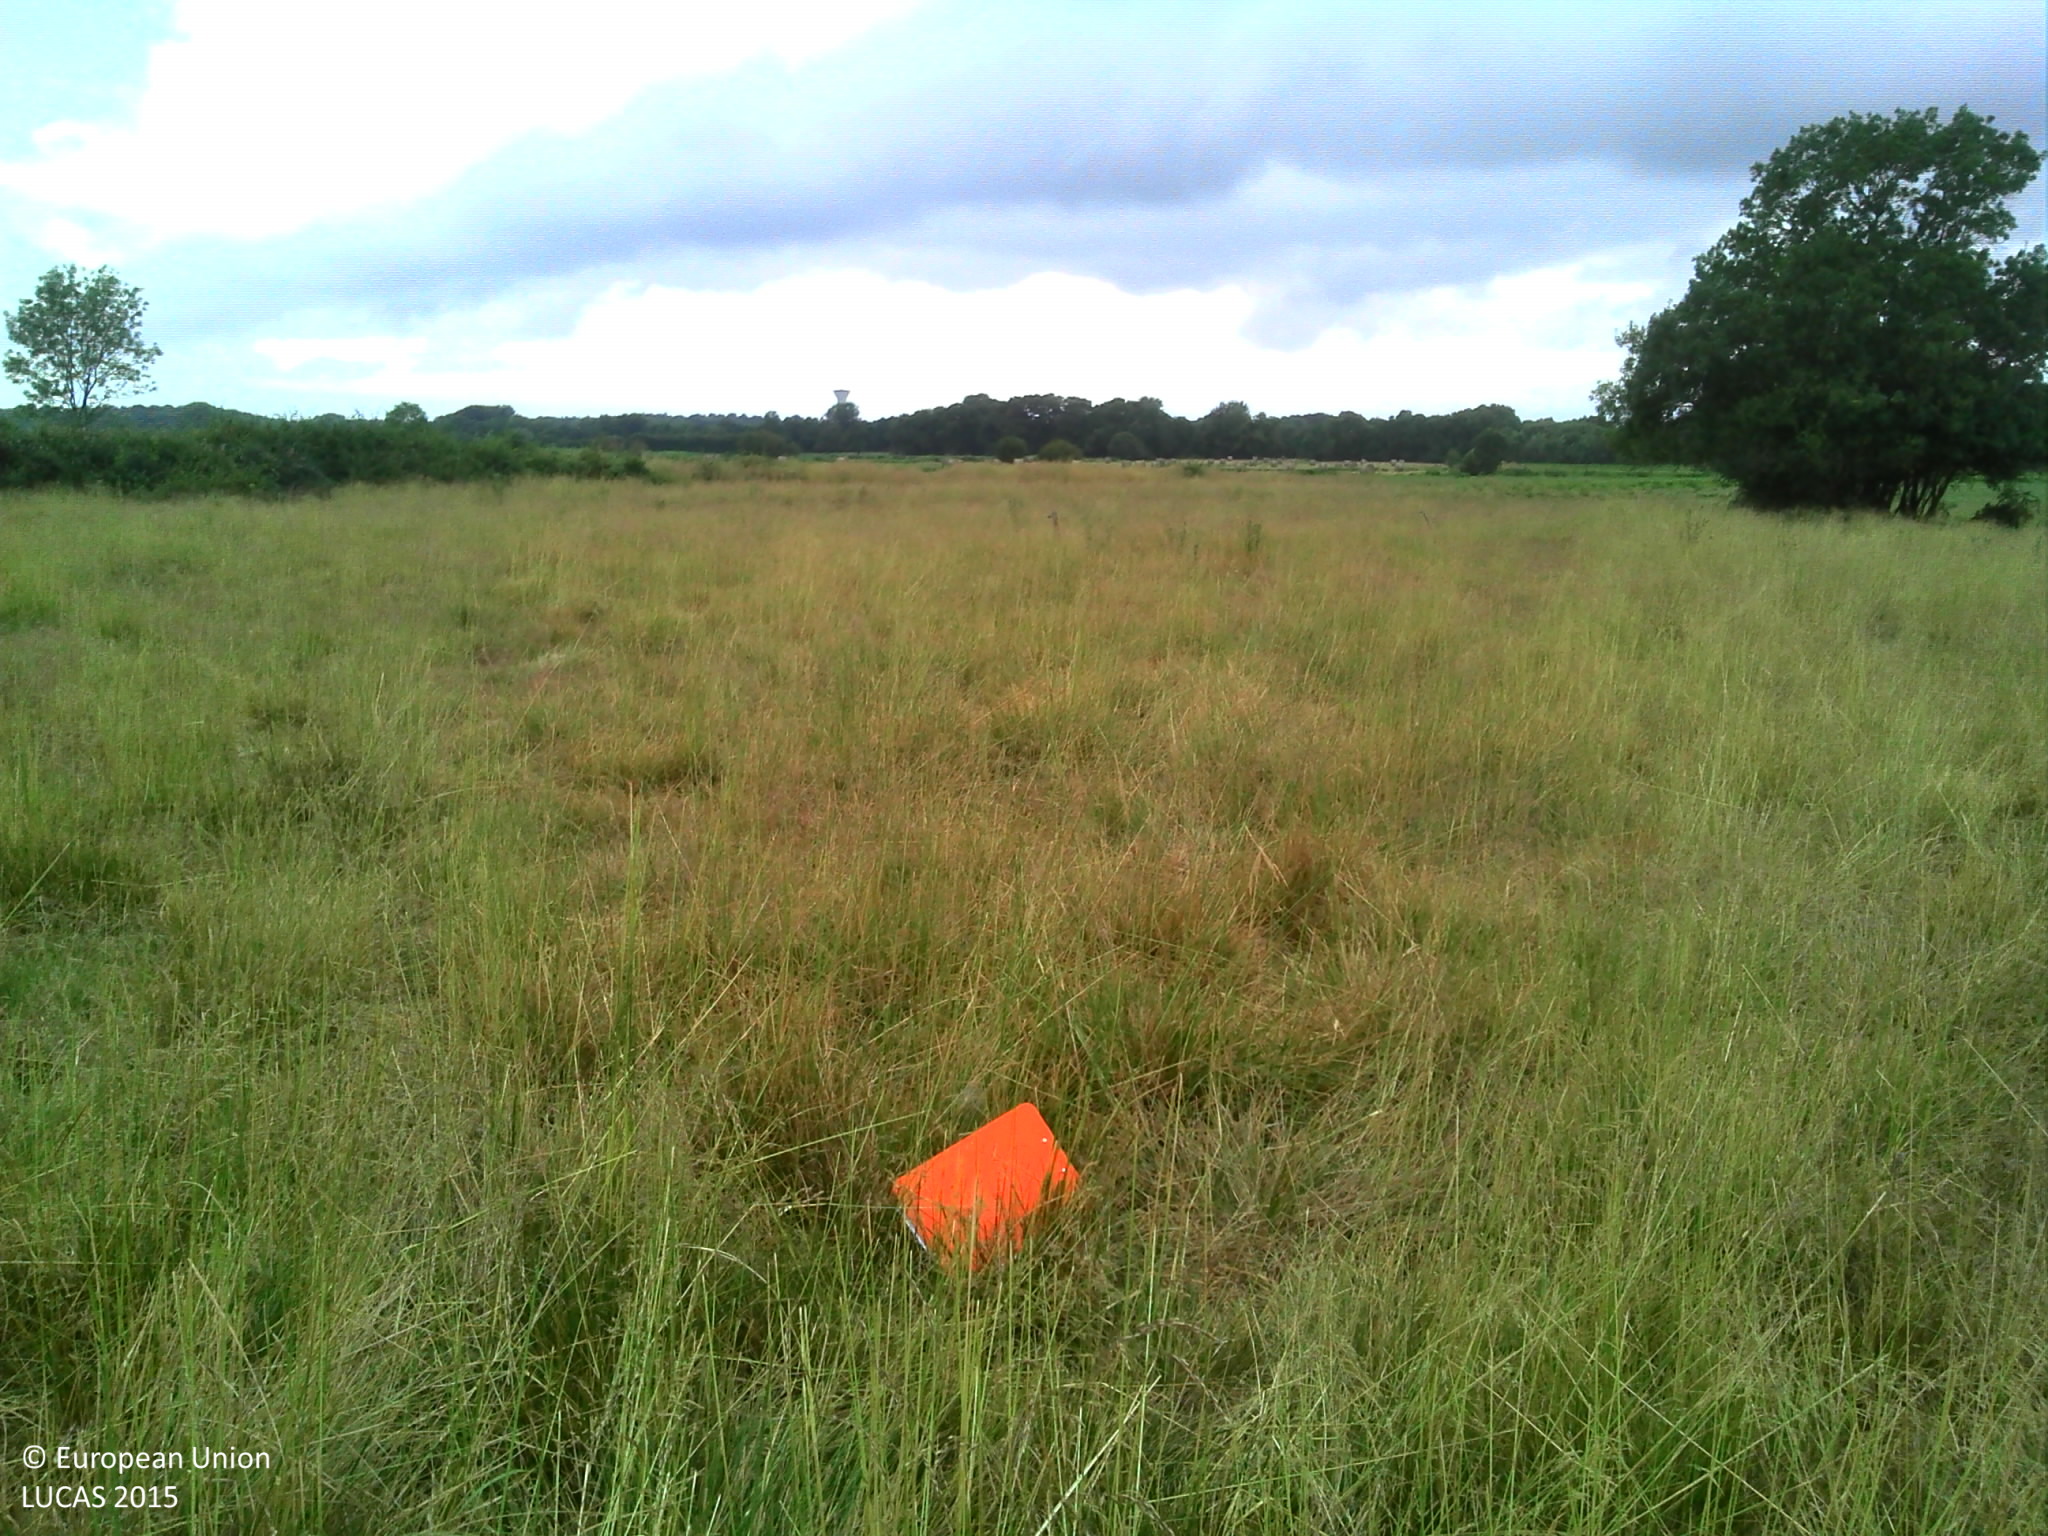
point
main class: Grassland
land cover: Grassland without tree/shrub cover
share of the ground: > 75 %
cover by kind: herbaceous plants 100 %
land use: Agriculture (excluding fallow land and kitchen gardens)
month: July
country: FR
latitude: 47.1009
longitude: -1.7576
